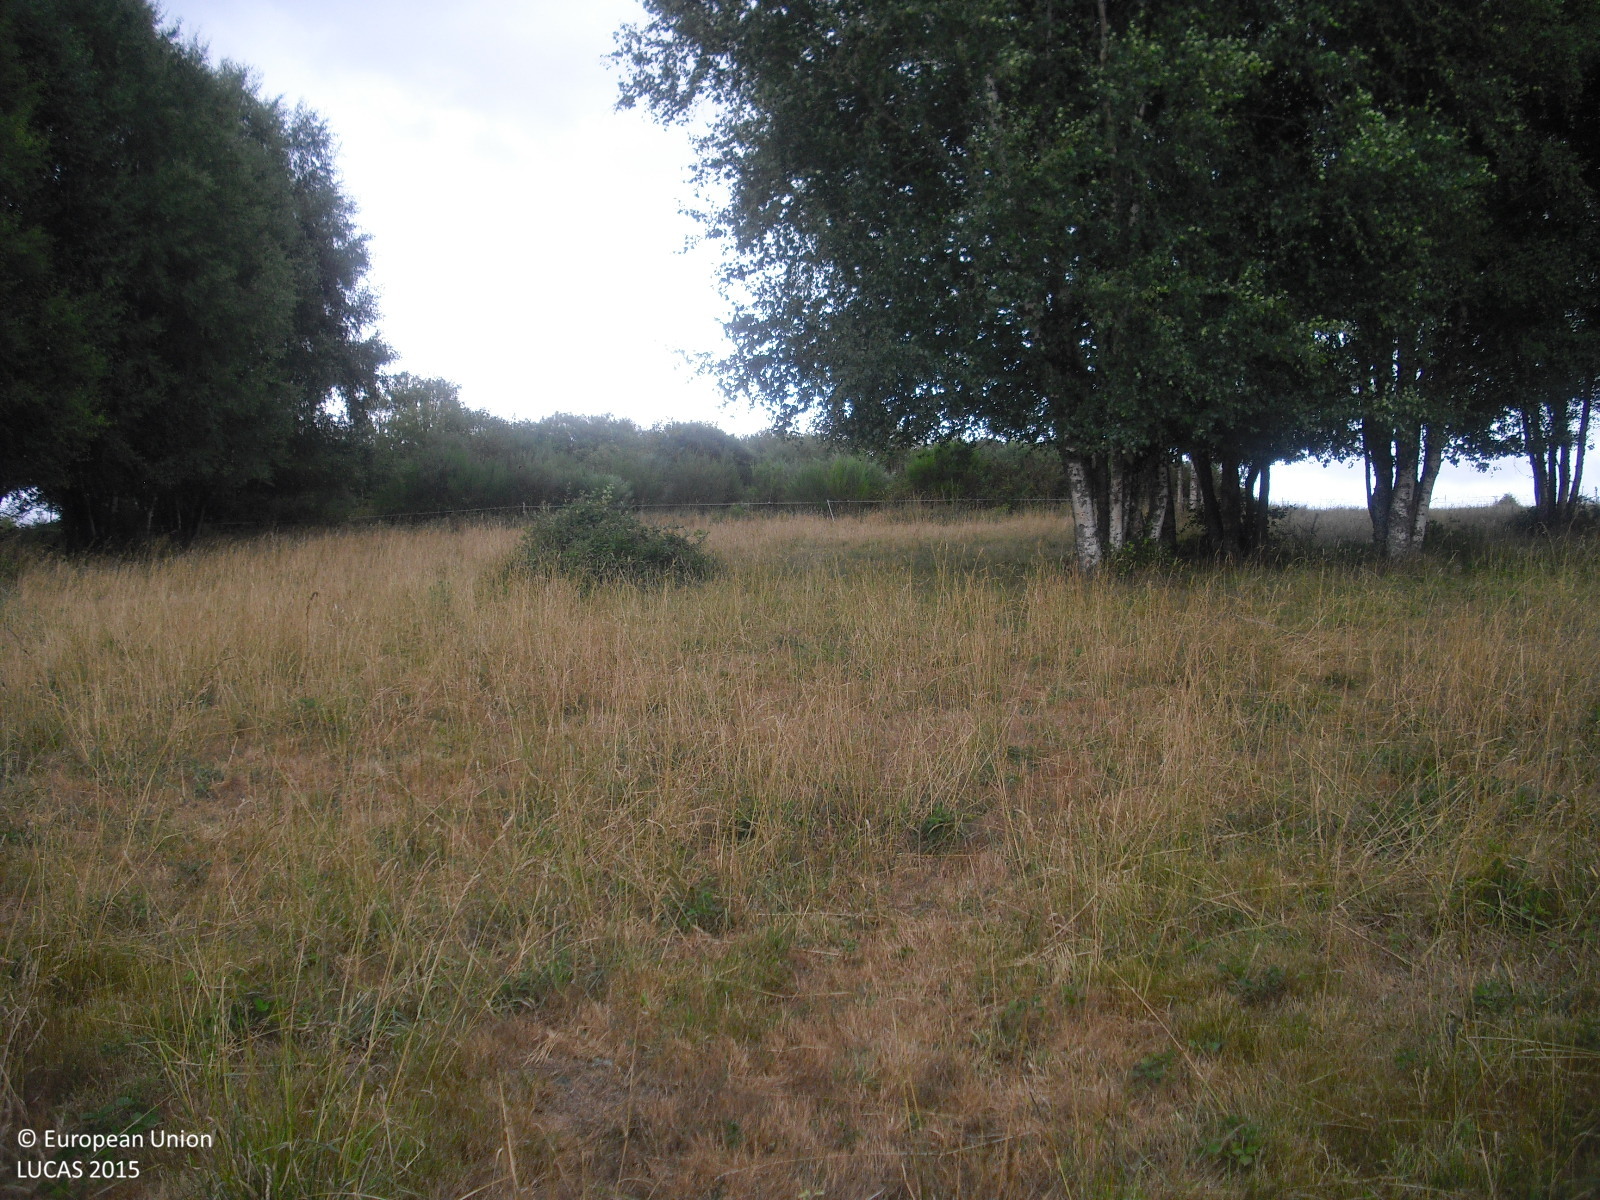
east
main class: Grassland
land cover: Grassland without tree/shrub cover
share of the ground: > 75 %
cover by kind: herbaceous plants 95 %, shrubs 5 %
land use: Agriculture (excluding fallow land and kitchen gardens)
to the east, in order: Grassland without tree/shrub cover; Shrubland without tree cover; Shrubland with sparse tree cover; Grassland without tree/shrub cover; Fences; Grassland without tree/shrub cover; Fences; Grassland without tree/shrub cover; Fences; Shruby margins; Paved roads, cycling and walking lanes; Ditches and canals; Shruby margins; Fences; Grassland without tree/shrub cover
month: July
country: ES
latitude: 42.3878
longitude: -7.3985
